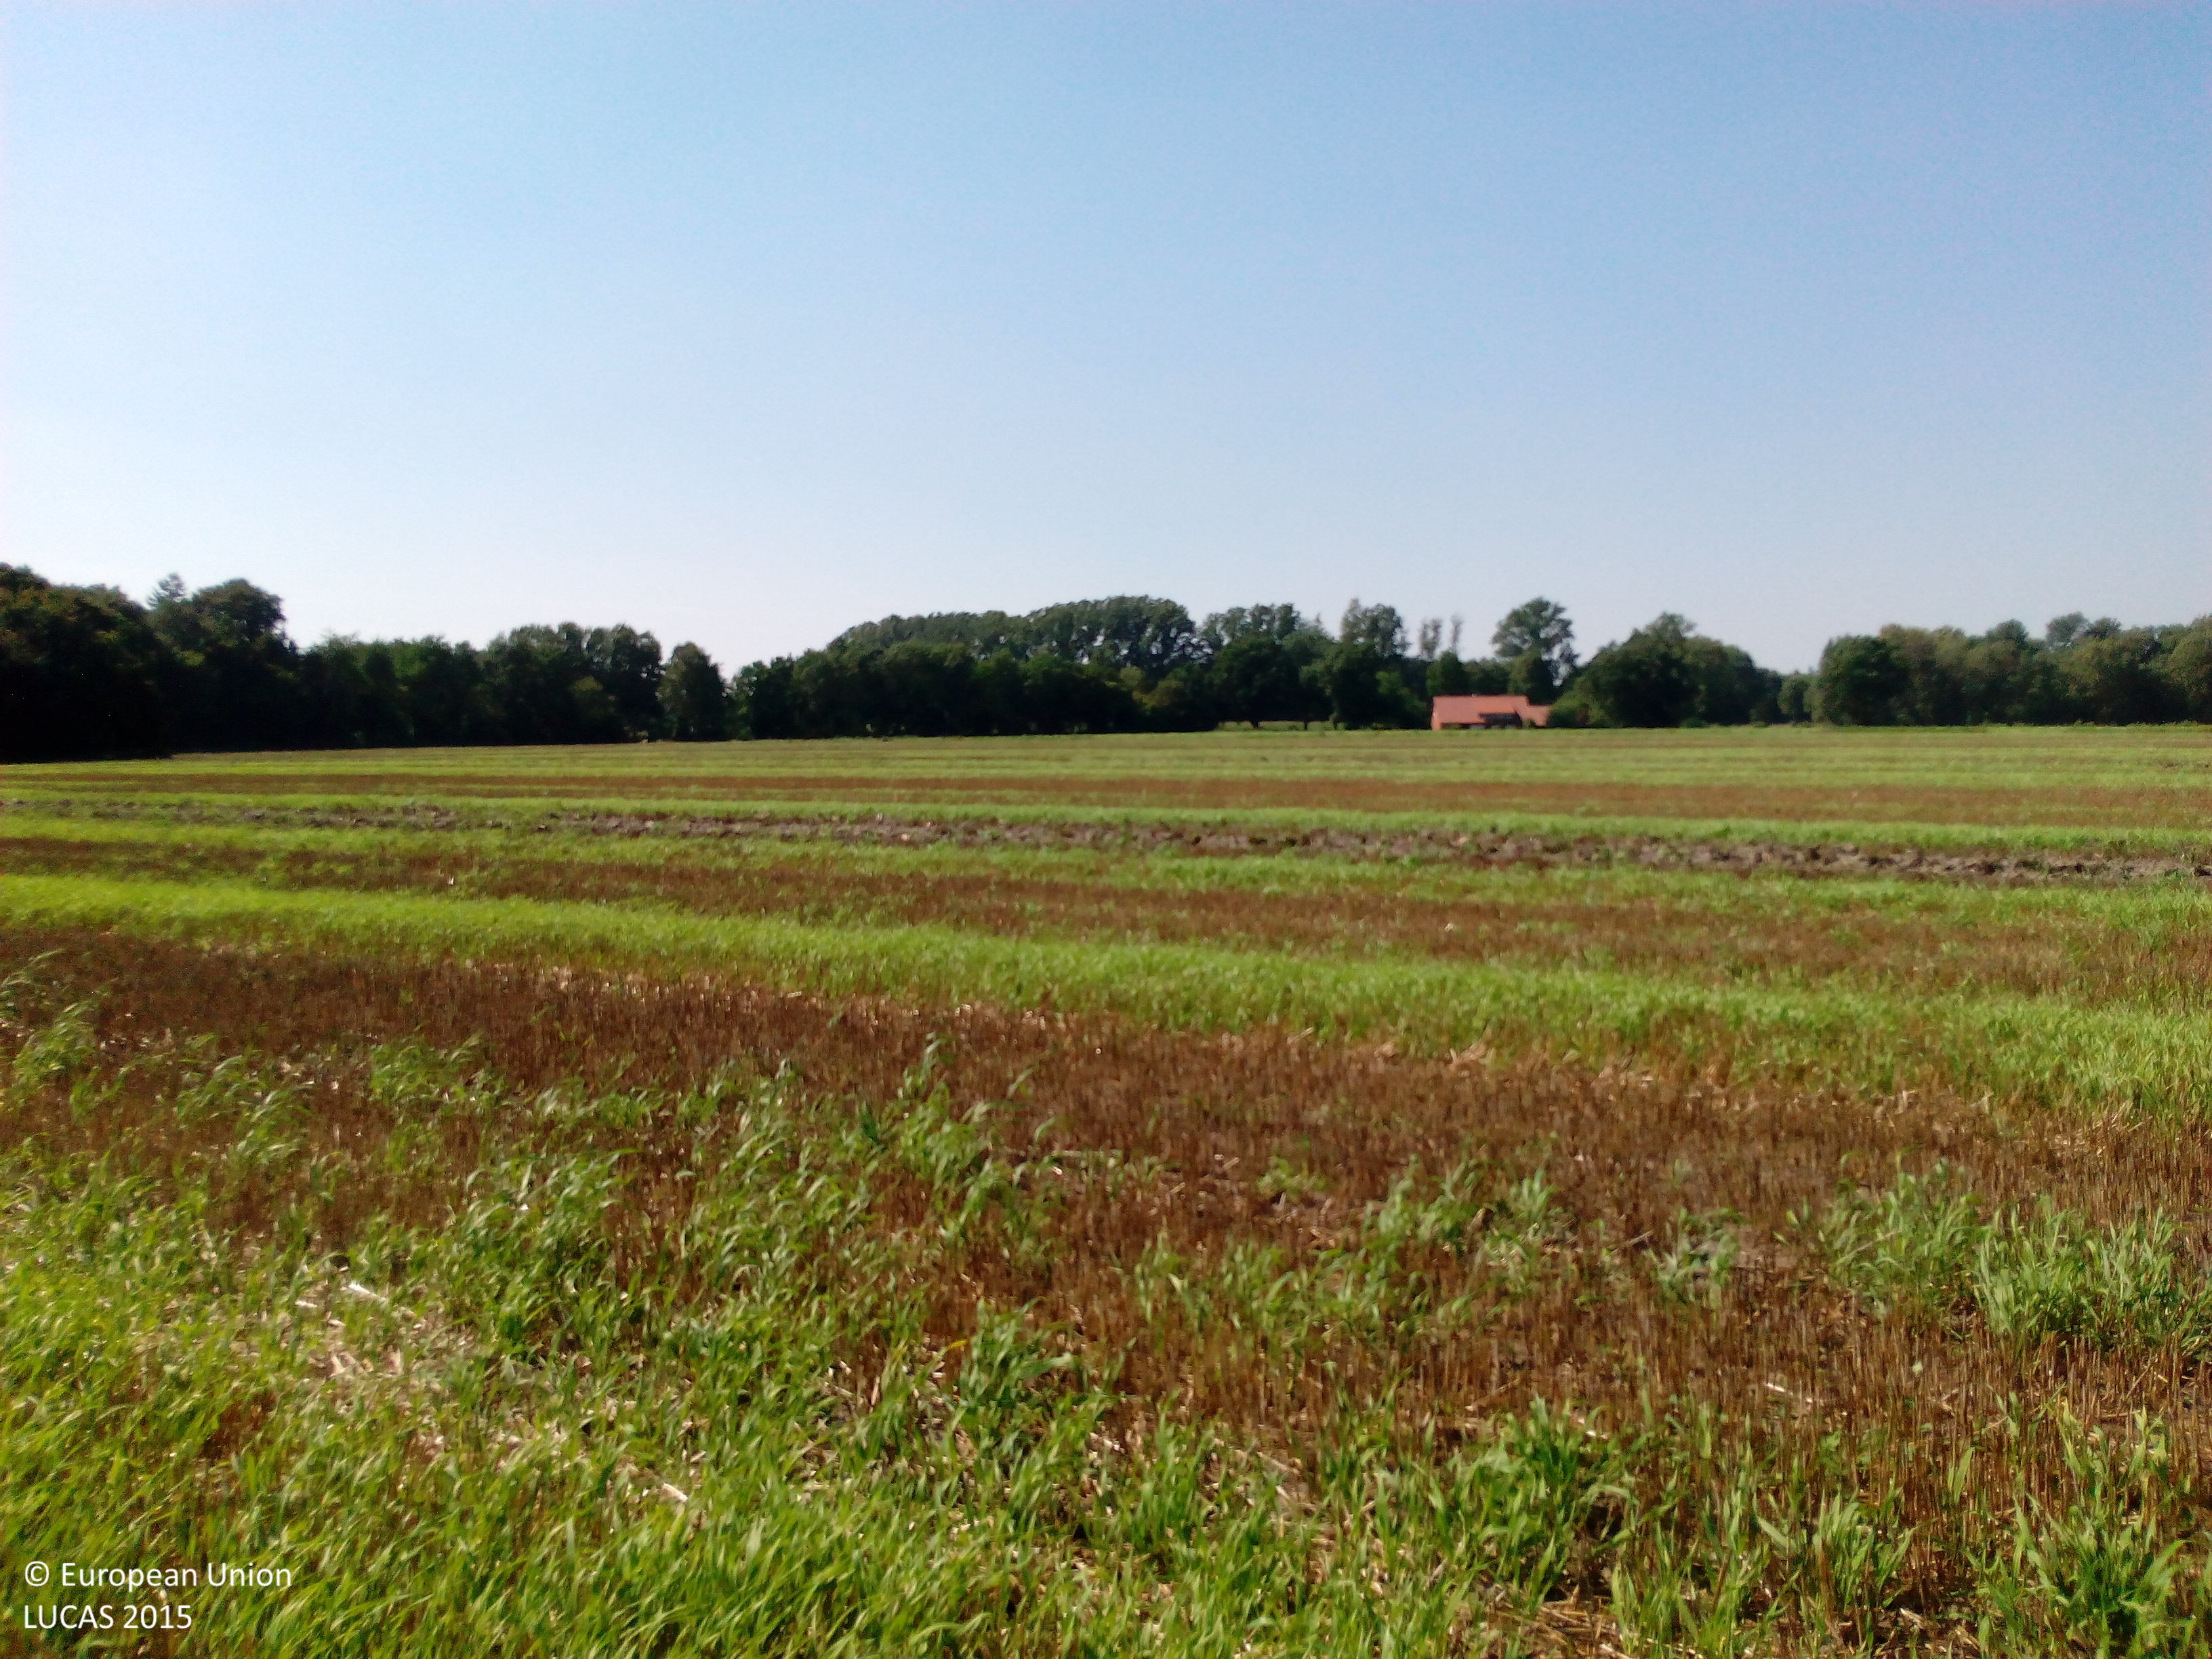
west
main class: Cropland
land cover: Barley
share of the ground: > 75 %
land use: Agriculture (excluding fallow land and kitchen gardens)
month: August
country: DE
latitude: 52.7562
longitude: 8.0002
